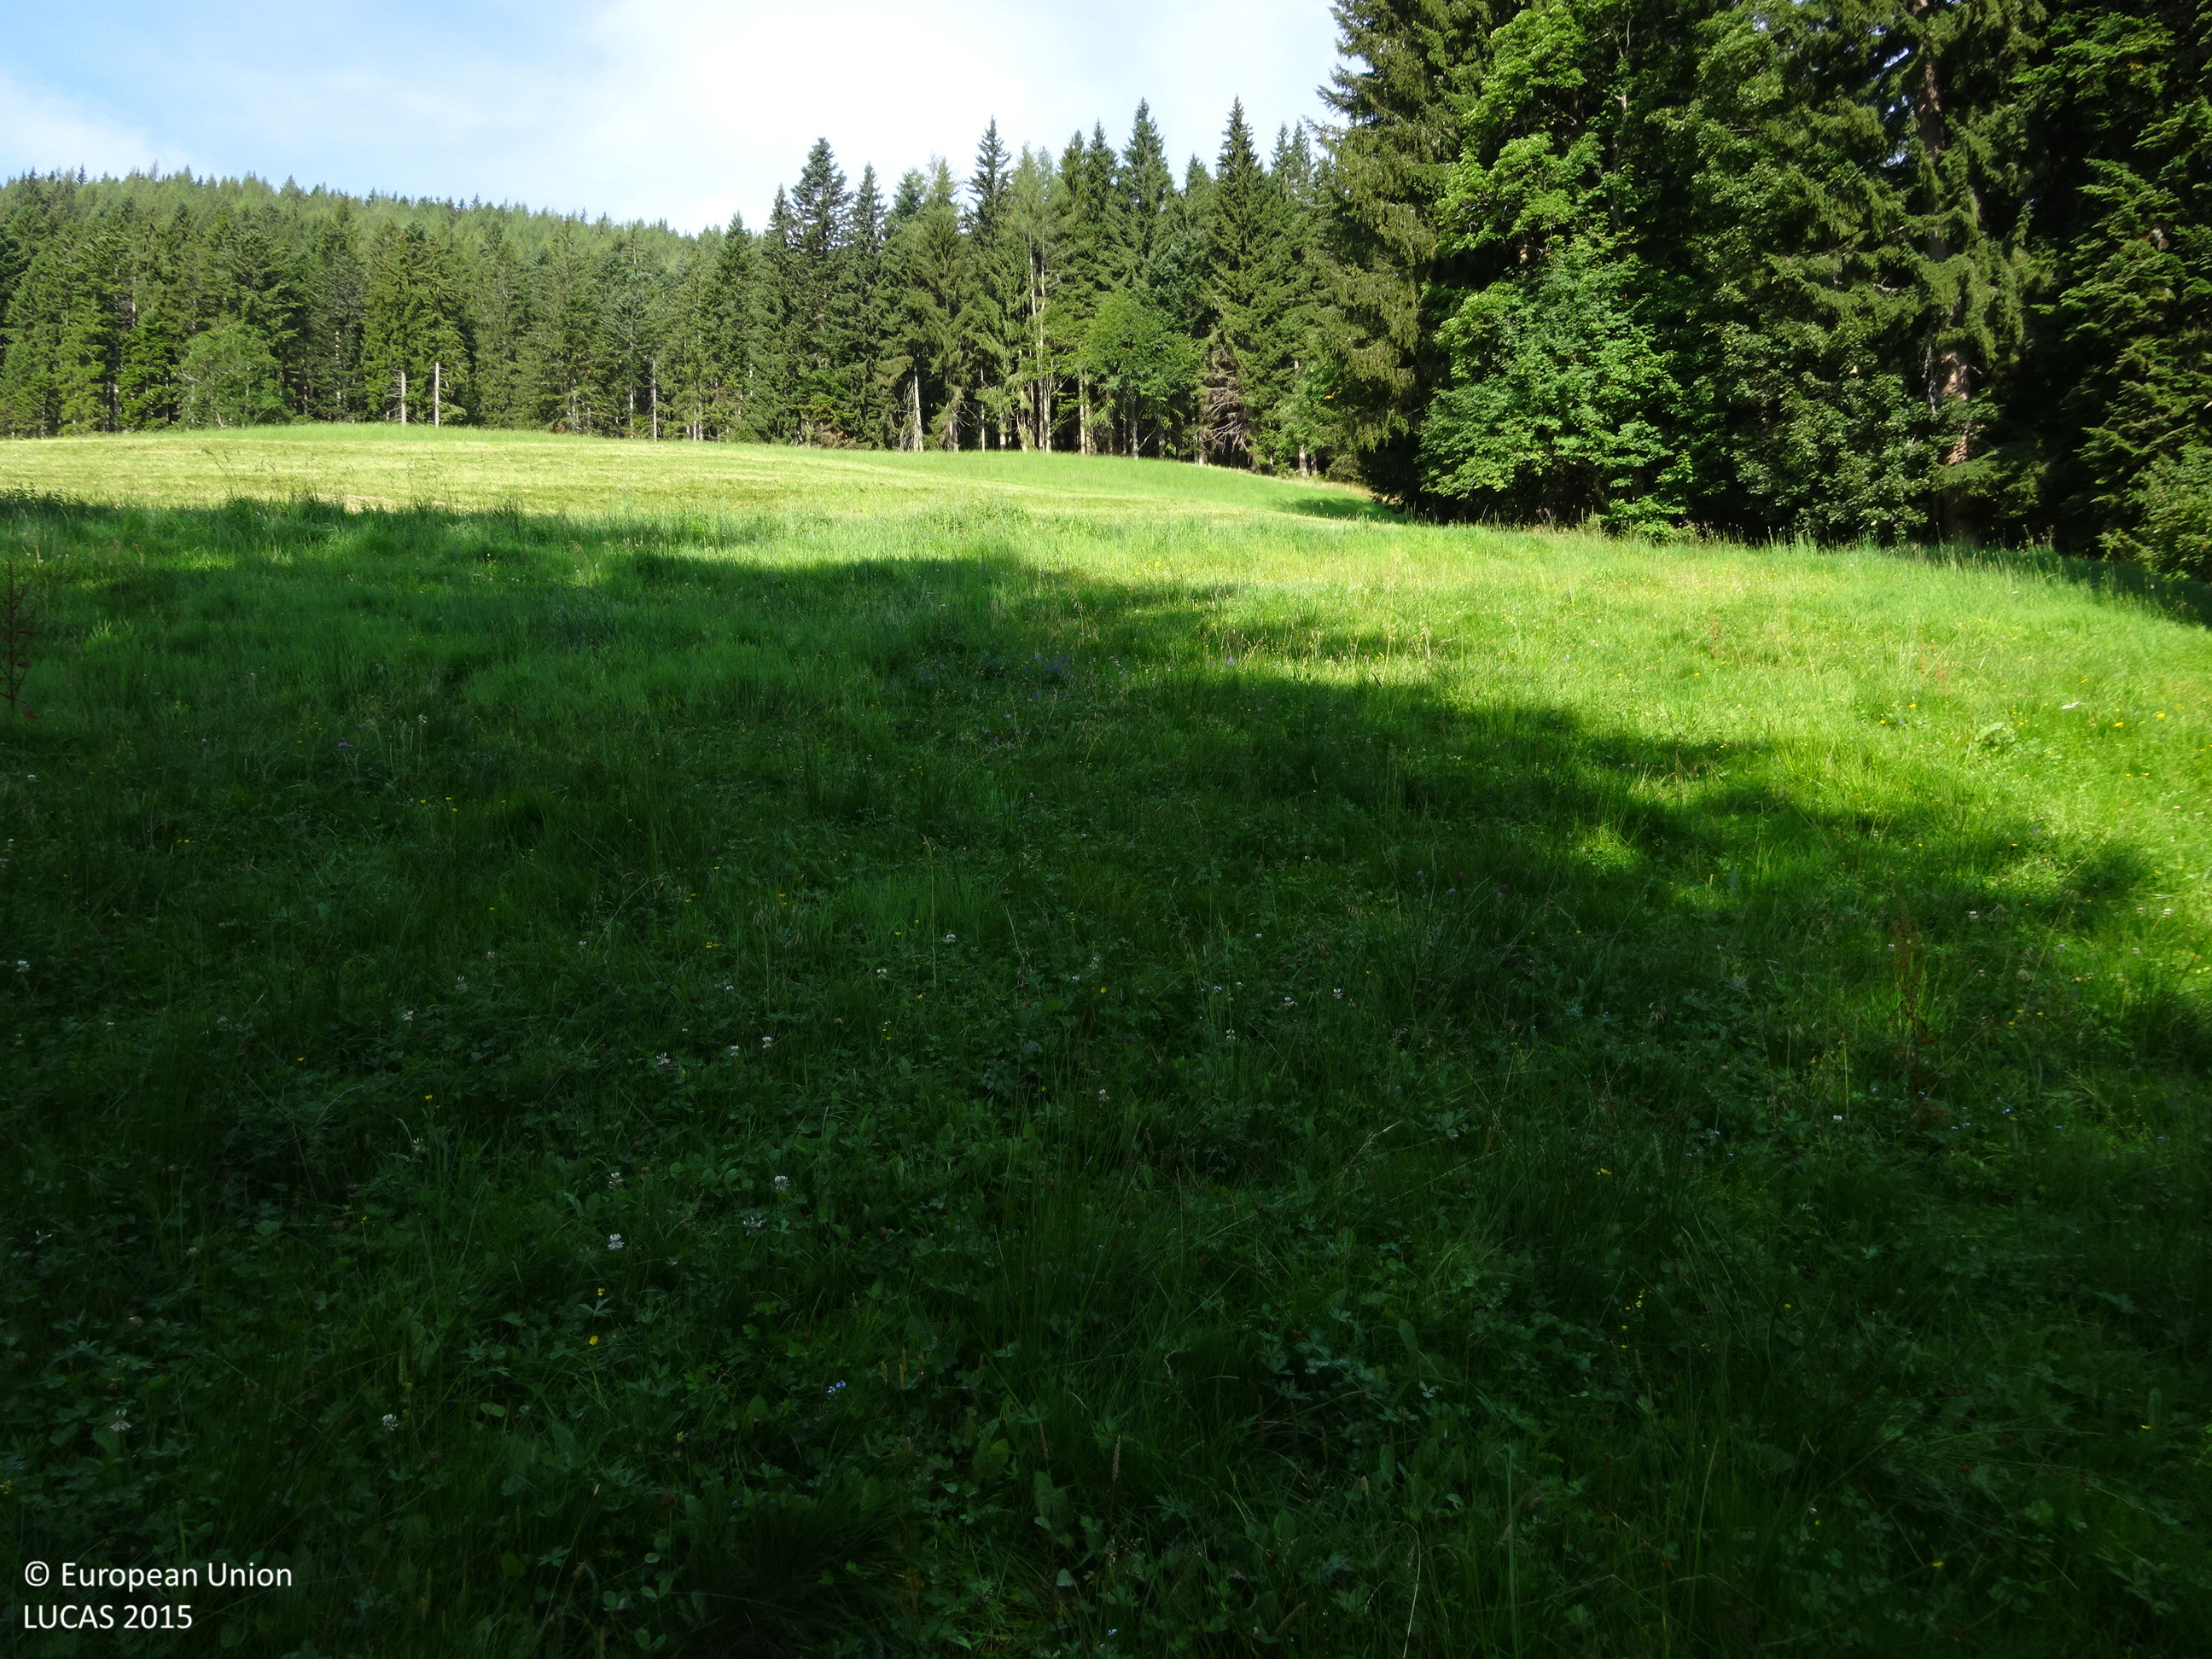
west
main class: Grassland
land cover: Grassland without tree/shrub cover
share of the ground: > 75 %
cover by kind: herbaceous plants 100 %
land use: Agriculture (excluding fallow land and kitchen gardens)
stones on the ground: < 10 %
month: August
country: AT
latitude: 47.5486
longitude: 15.7818
